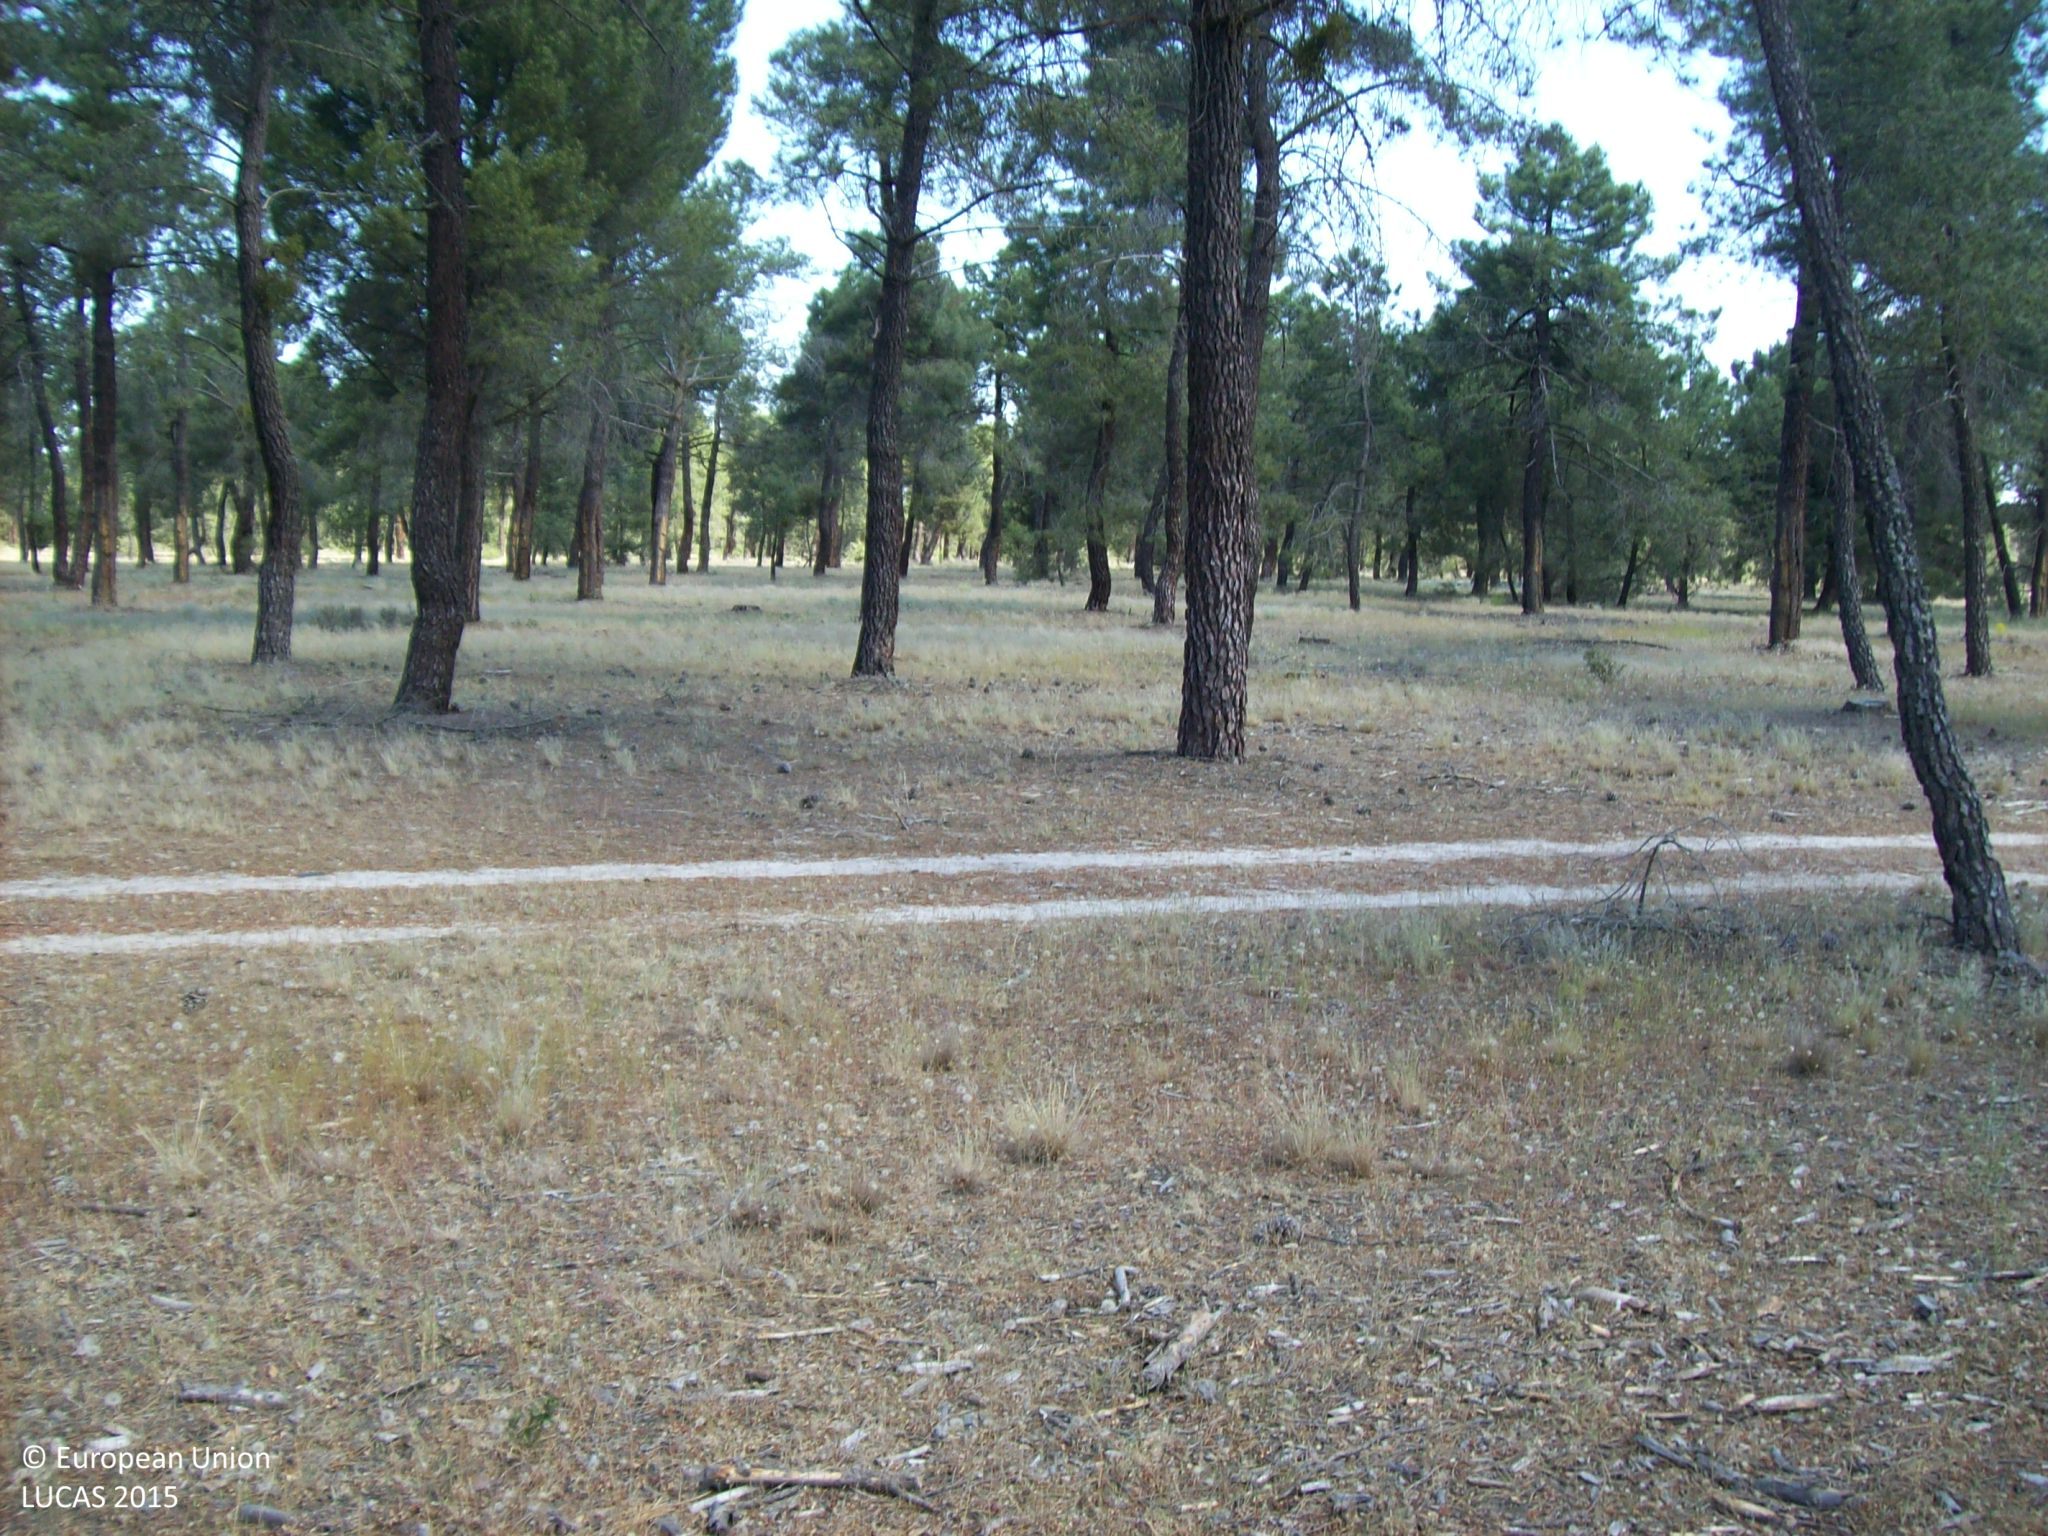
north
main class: Woodland
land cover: Pine dominated coniferous woodland
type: coniferous forest of the mediterranean region
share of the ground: 25 - 50 %
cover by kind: herbaceous plants 50 %, coniferous forest trees 45 %, unconsolidated bare surface 5 %
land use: Forestry
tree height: > 5 m
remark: Clear cut
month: June
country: ES
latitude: 41.0136
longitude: -4.5288
